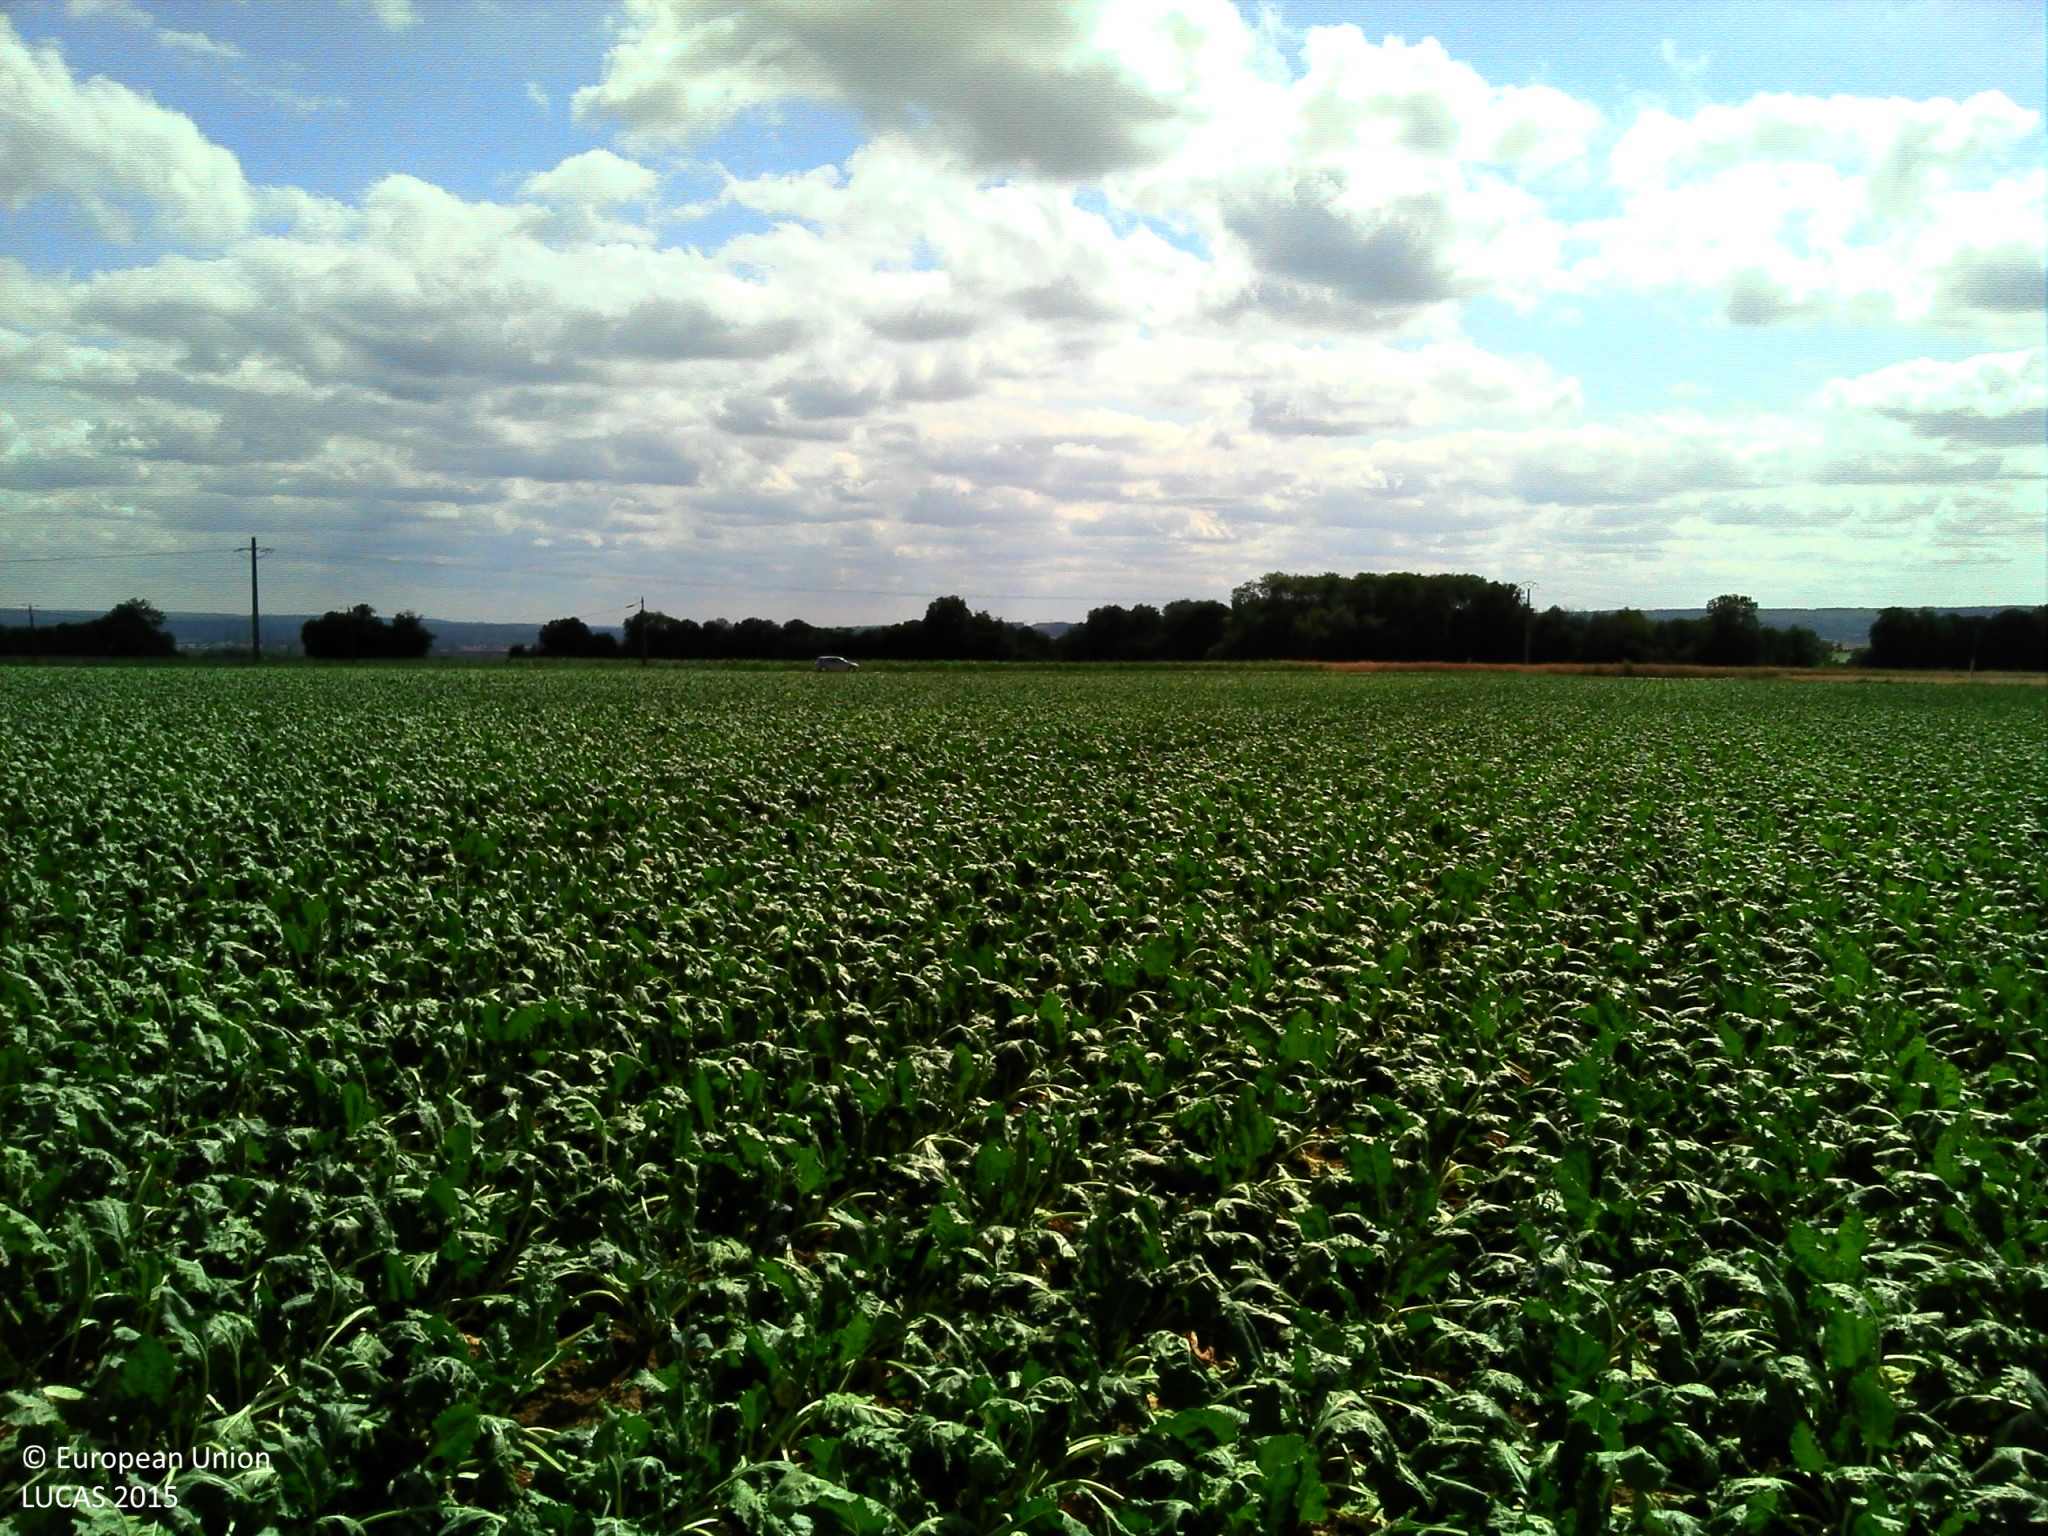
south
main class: Cropland
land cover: Sugar beet
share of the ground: > 75 %
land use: Agriculture (excluding fallow land and kitchen gardens)
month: July
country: FR
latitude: 49.2001
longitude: 2.2879
